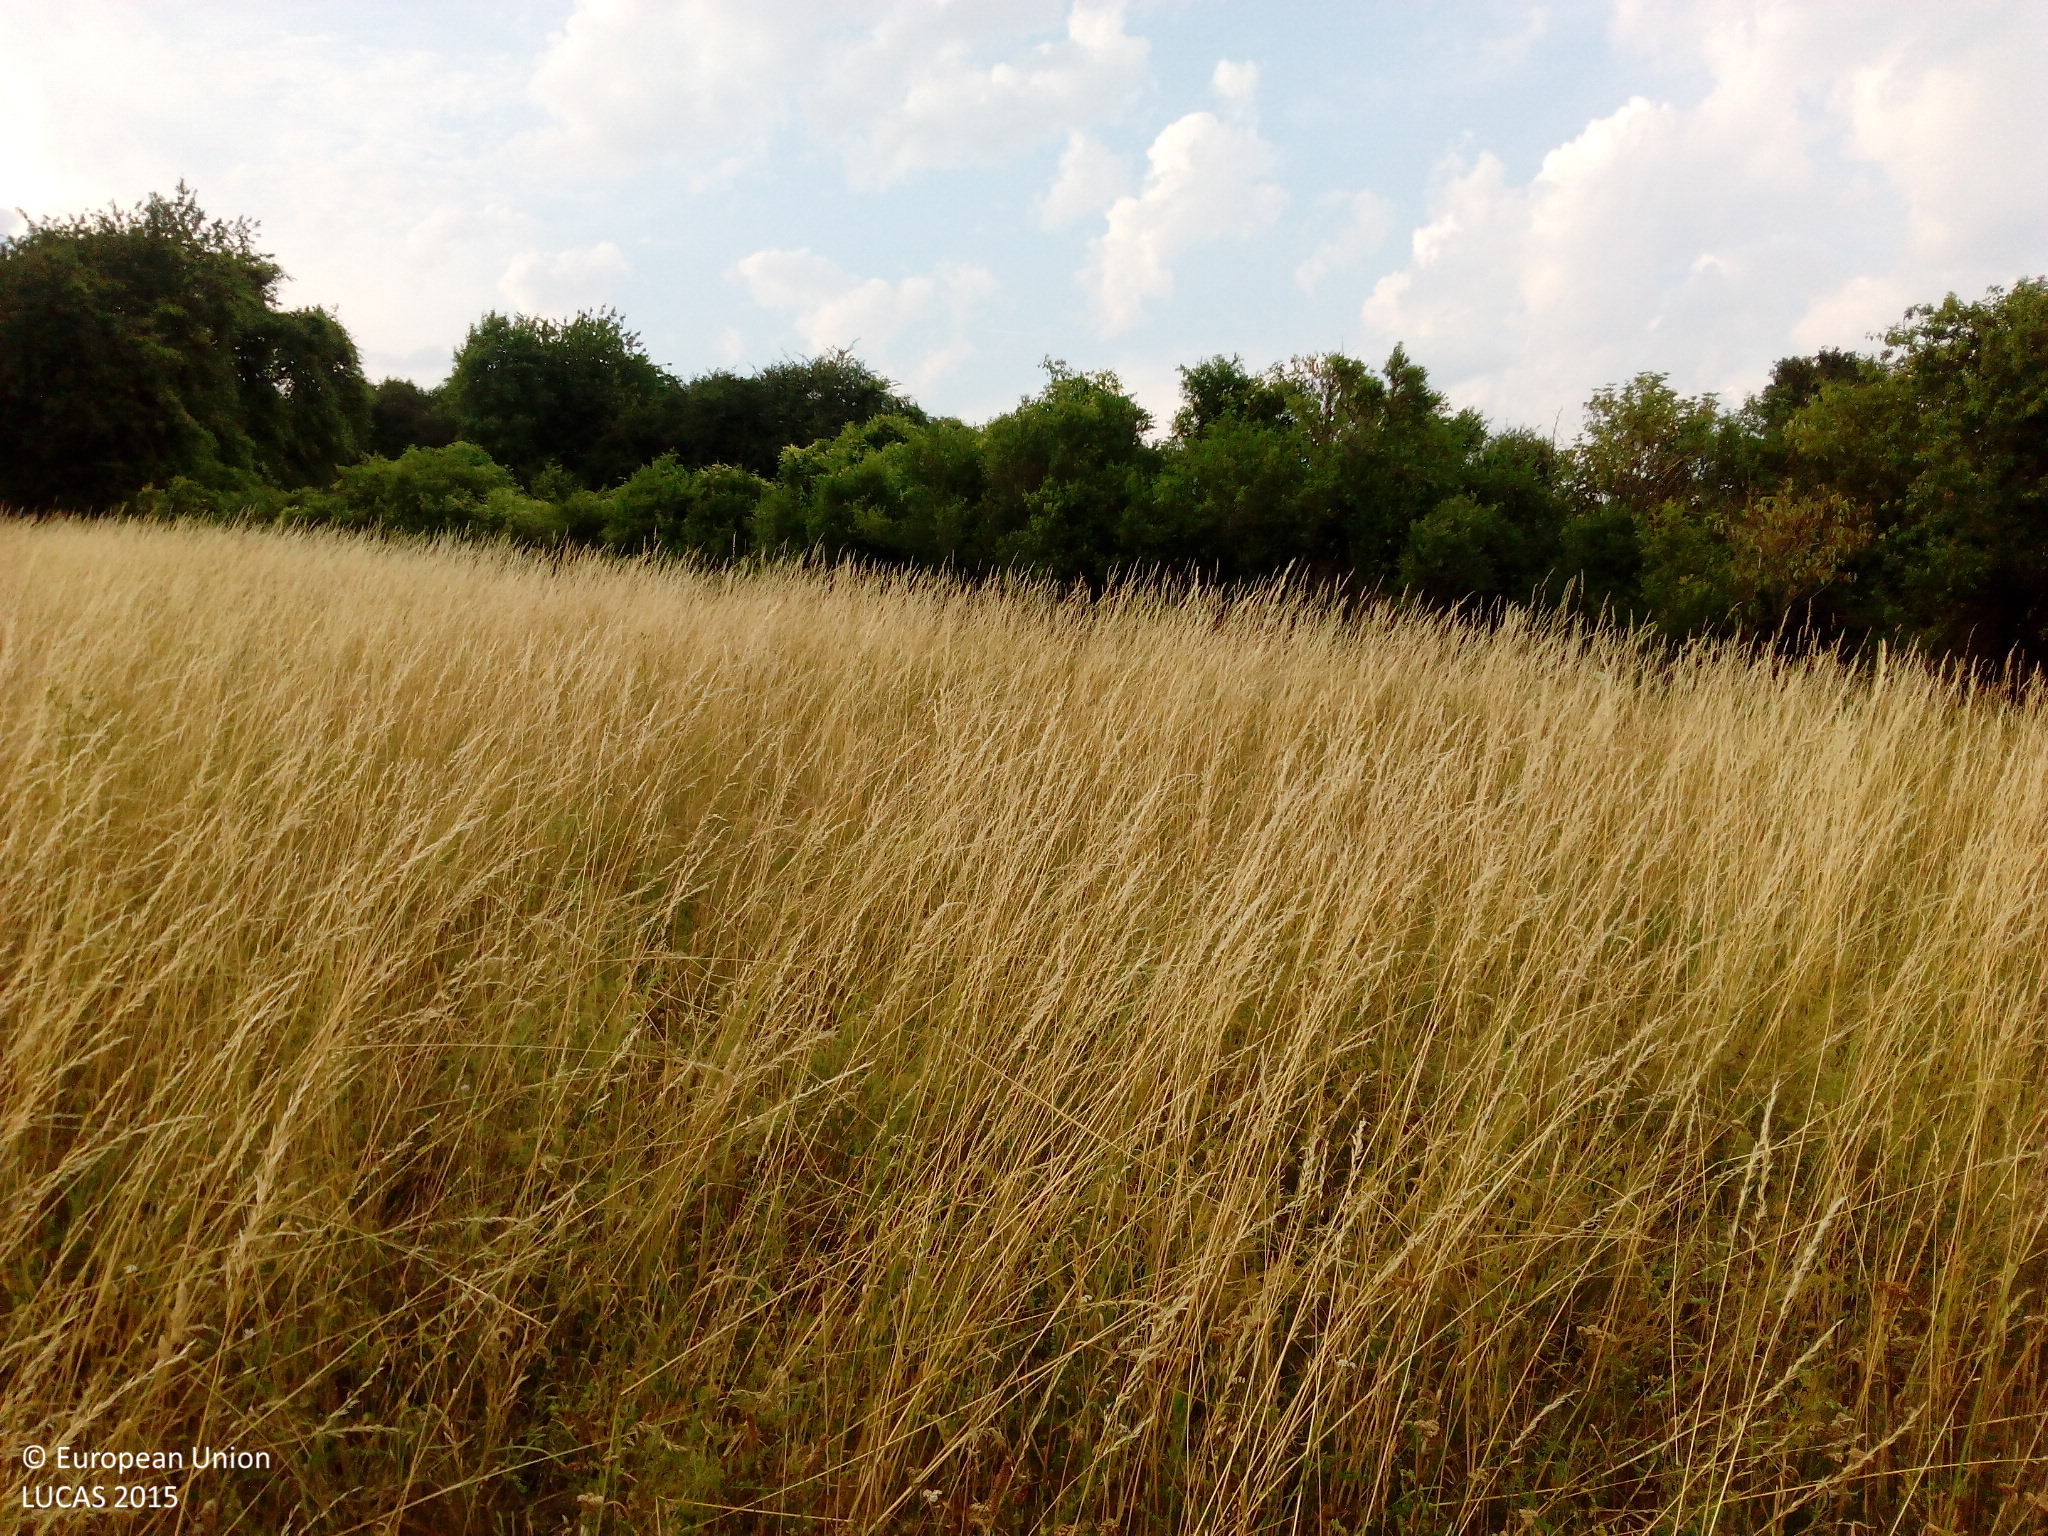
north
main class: Grassland
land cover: Grassland without tree/shrub cover
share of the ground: > 75 %
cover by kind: herbaceous plants 100 %
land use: Agriculture (excluding fallow land and kitchen gardens)
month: July
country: DE
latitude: 49.5188
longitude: 9.9586
